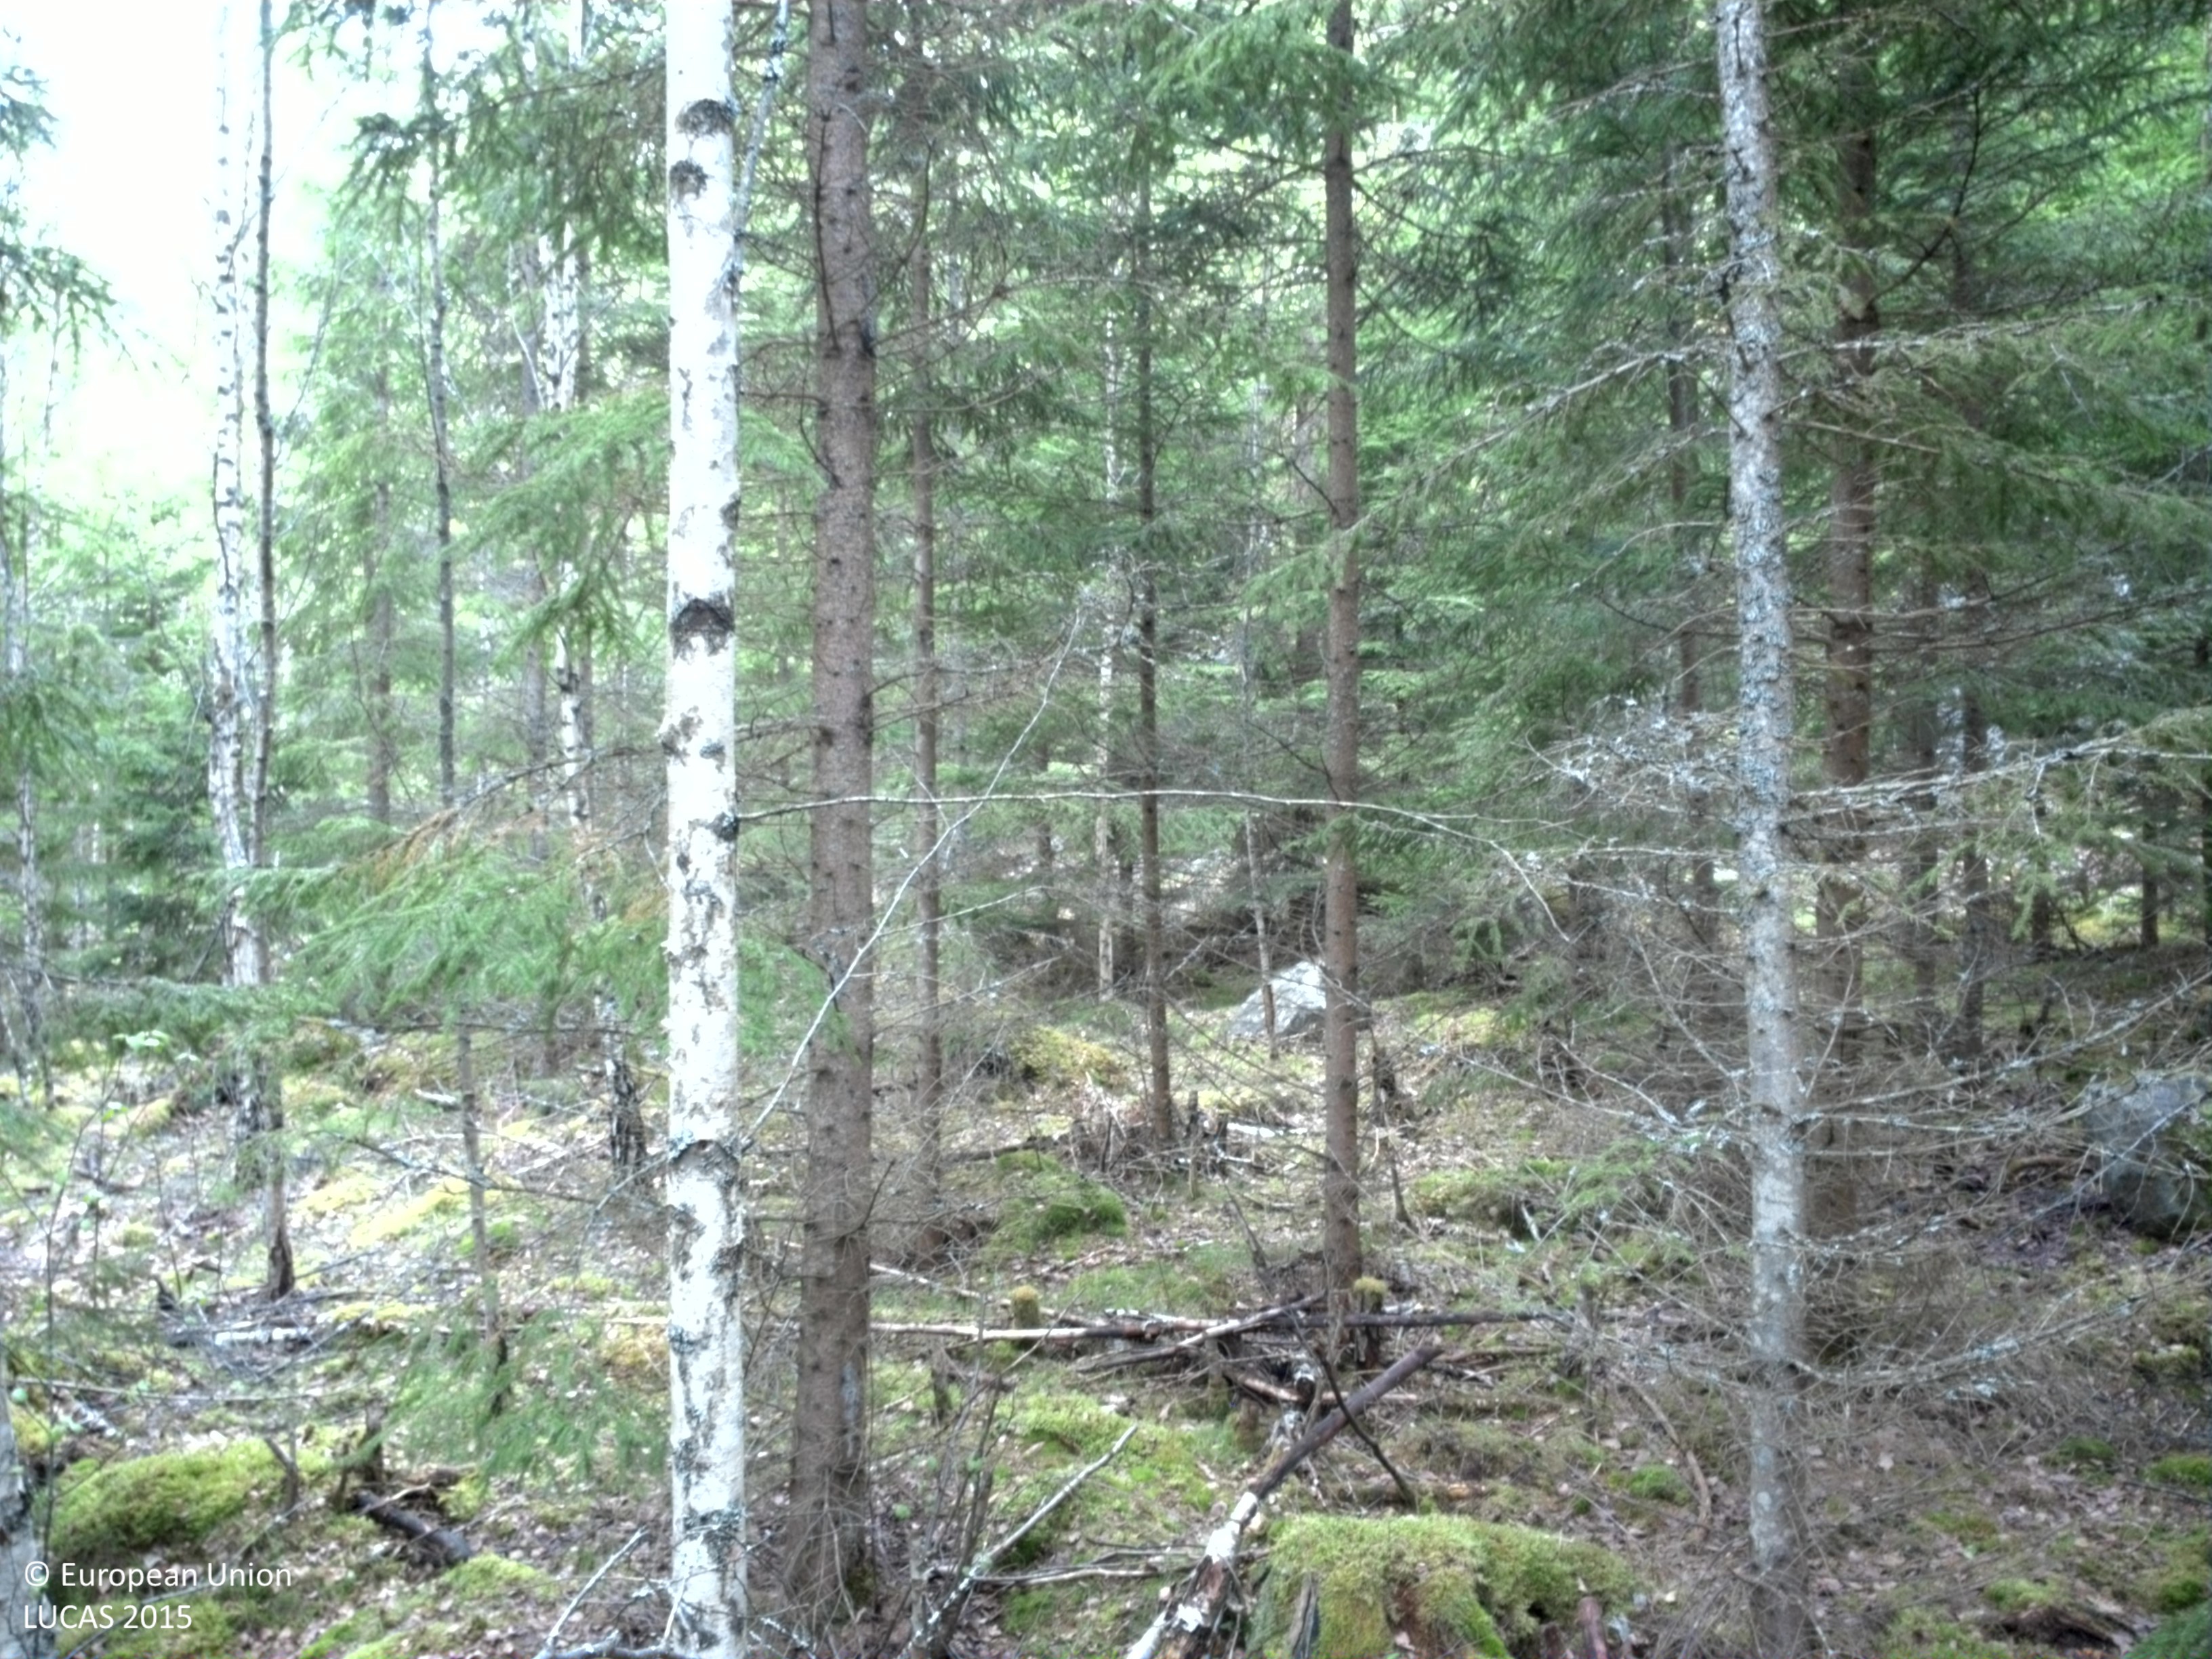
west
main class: Woodland
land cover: Spruce dominated mixed woodland
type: boreal forest
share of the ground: > 75 %
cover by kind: coniferous forest trees 40 %, broadleaved forest trees 40 %, lichens and mosses 20 %
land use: Forestry
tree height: > 5 m
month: May
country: SE
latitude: 56.7717
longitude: 15.0865
